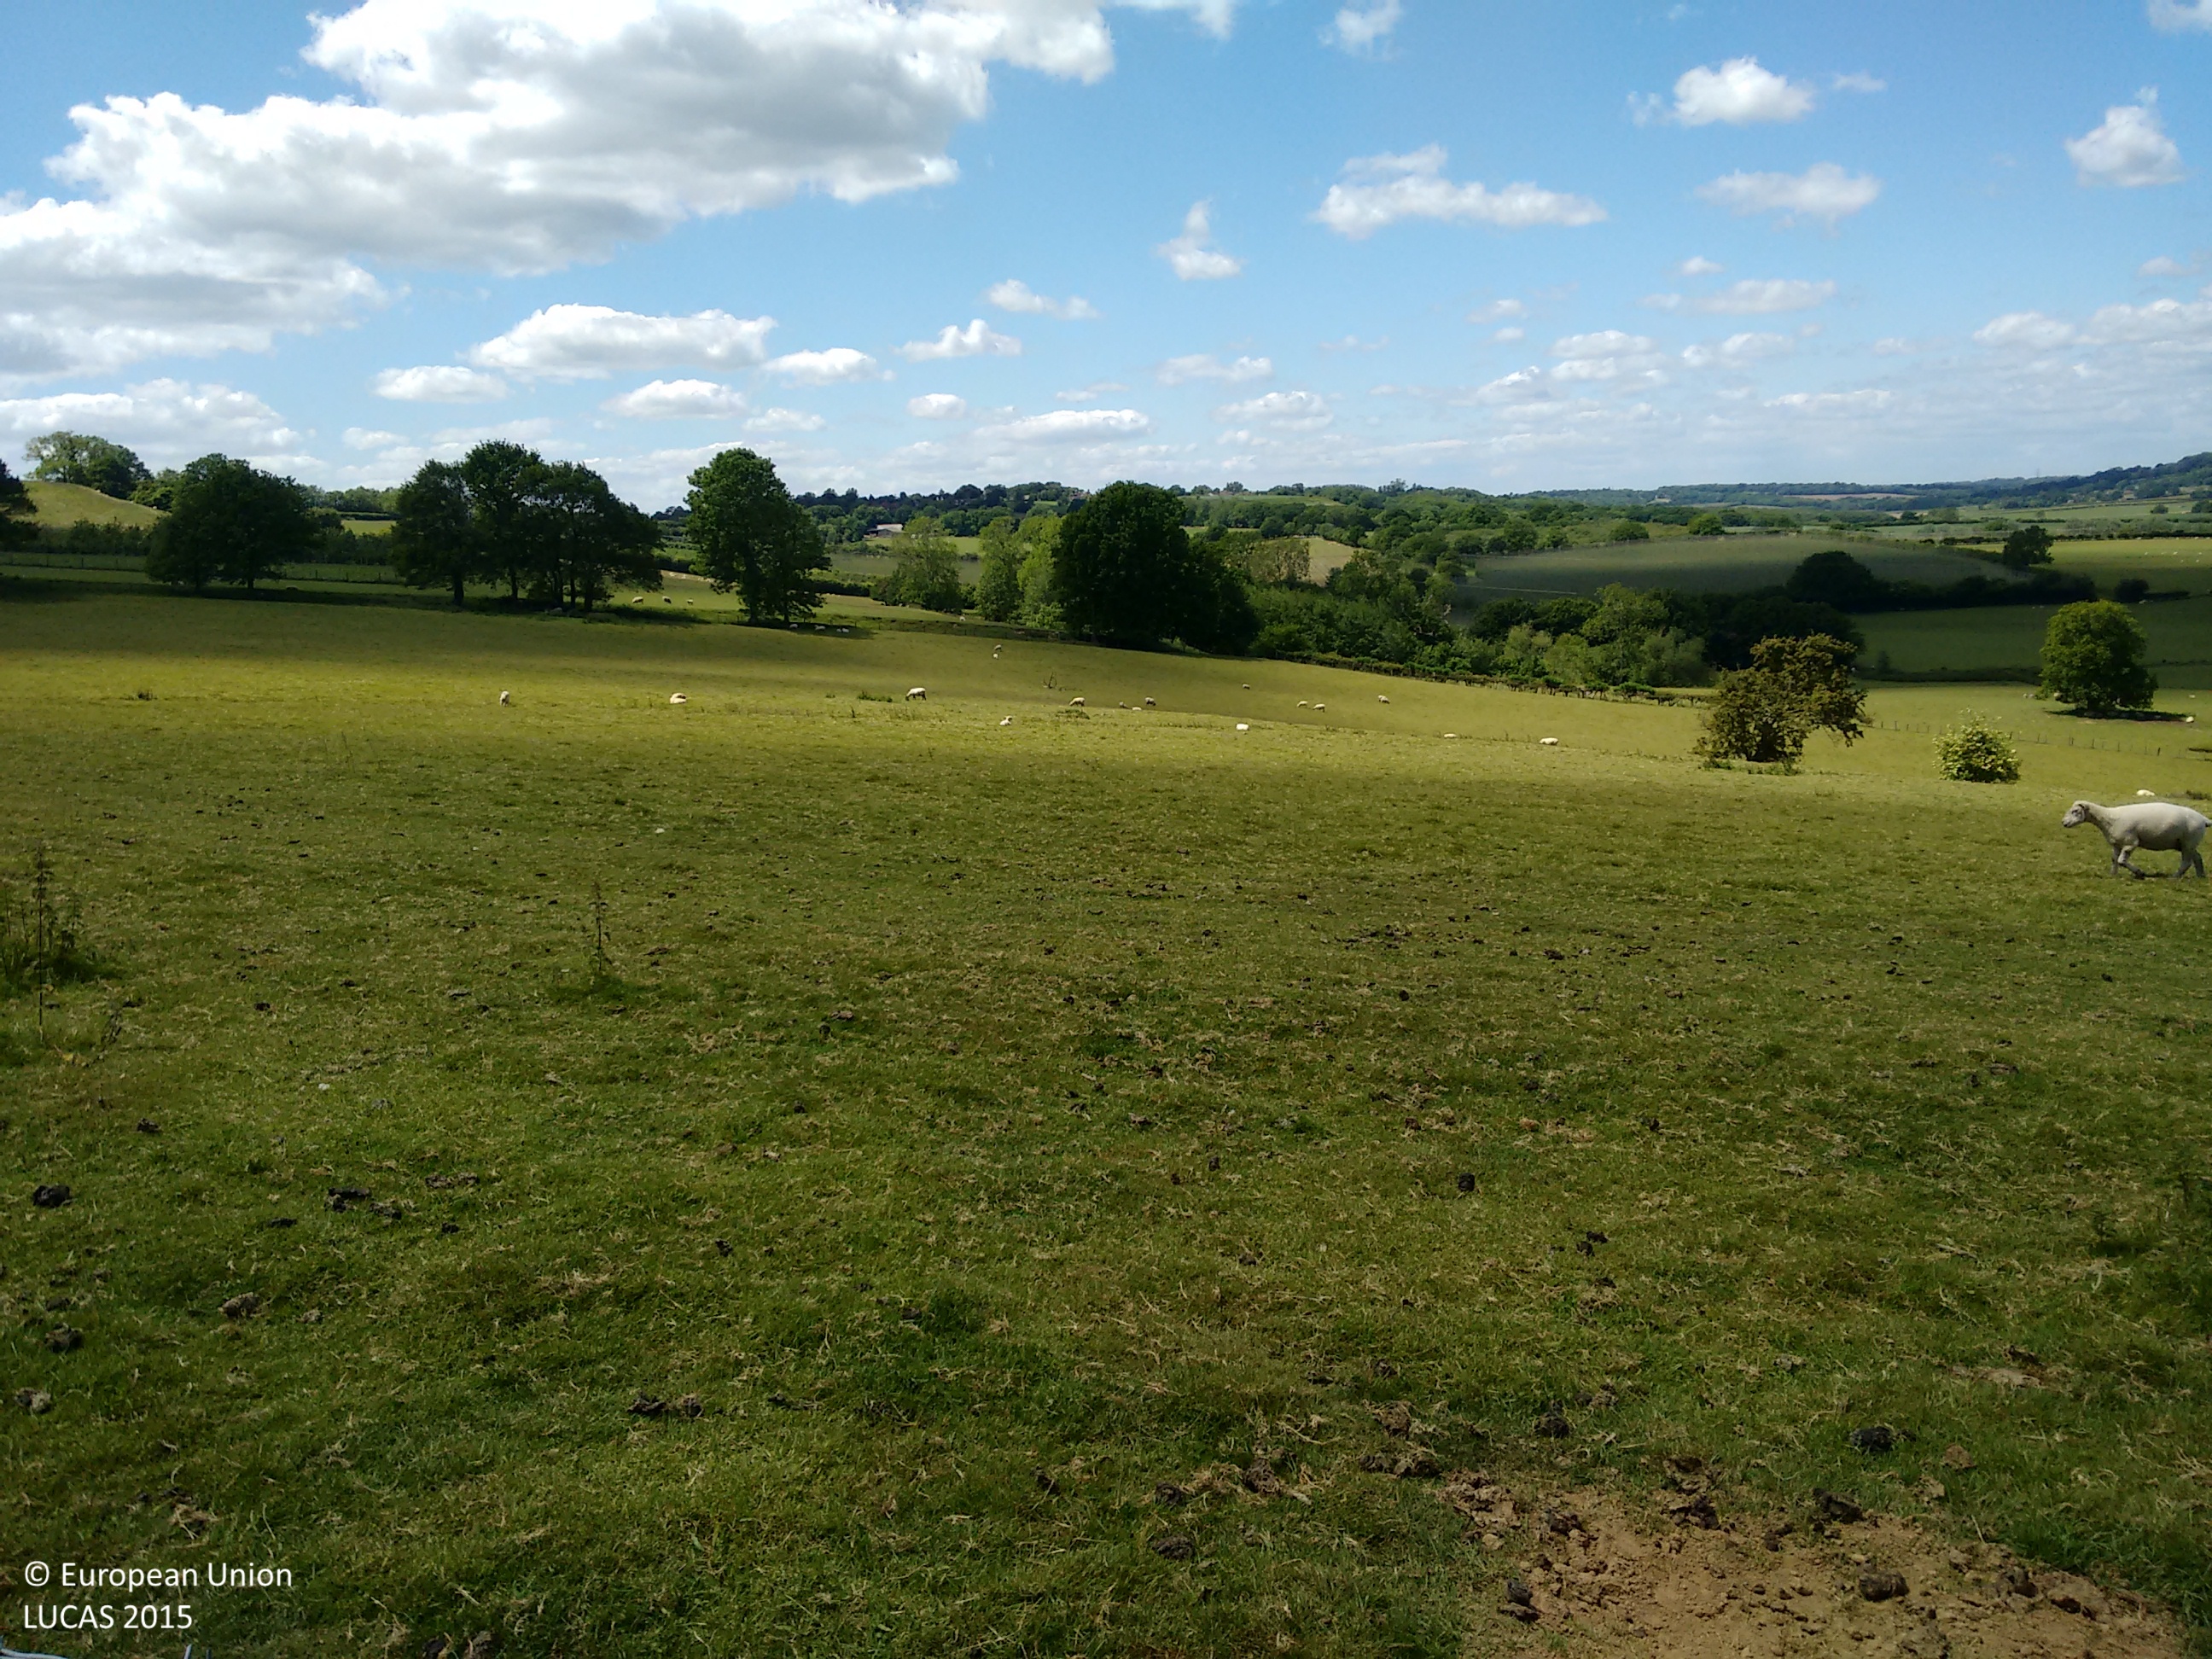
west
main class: Grassland
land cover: Grassland without tree/shrub cover
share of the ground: > 75 %
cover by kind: herbaceous plants 100 %
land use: Agriculture (excluding fallow land and kitchen gardens)
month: June
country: GB
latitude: 50.9422
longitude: 0.6804
